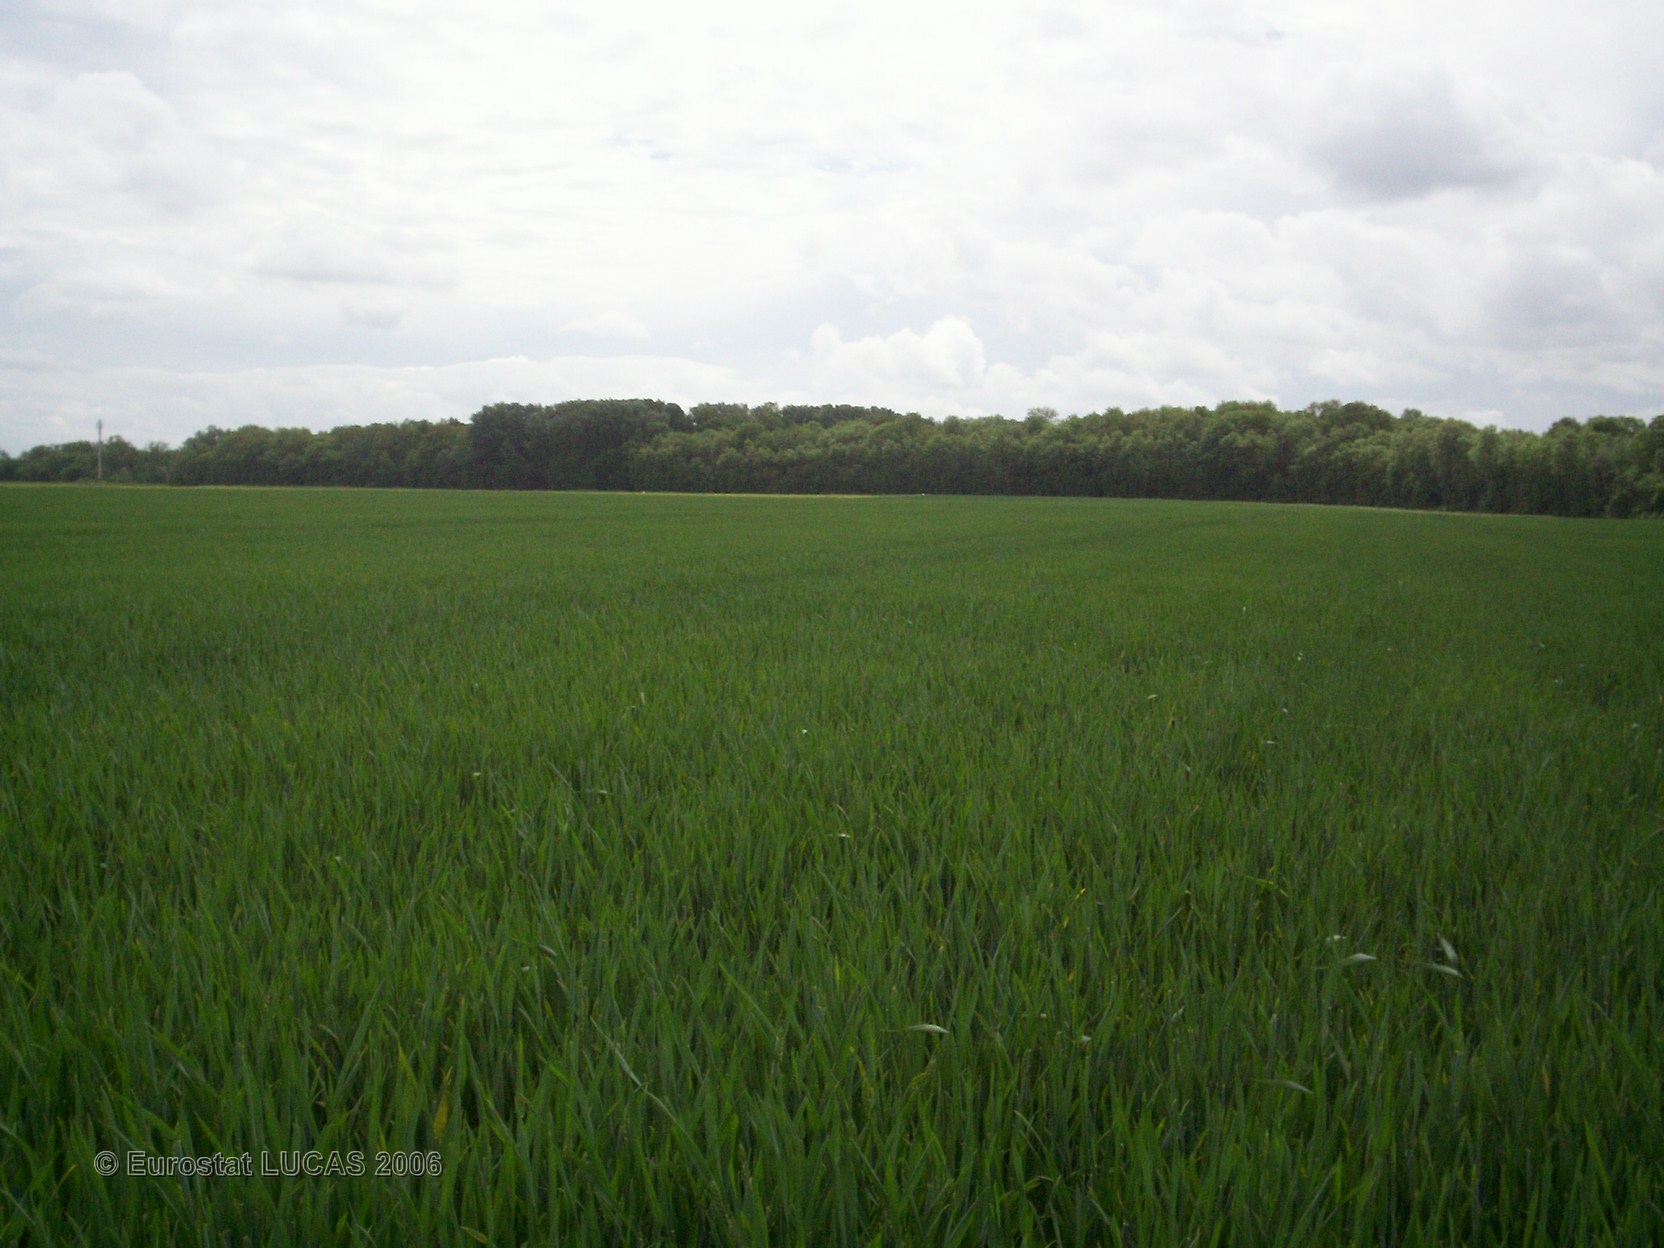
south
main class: Cropland
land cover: Common wheat
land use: Agriculture (excluding fallow land and kitchen gardens)
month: May
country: FR
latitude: 48.6748
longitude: 2.8066
